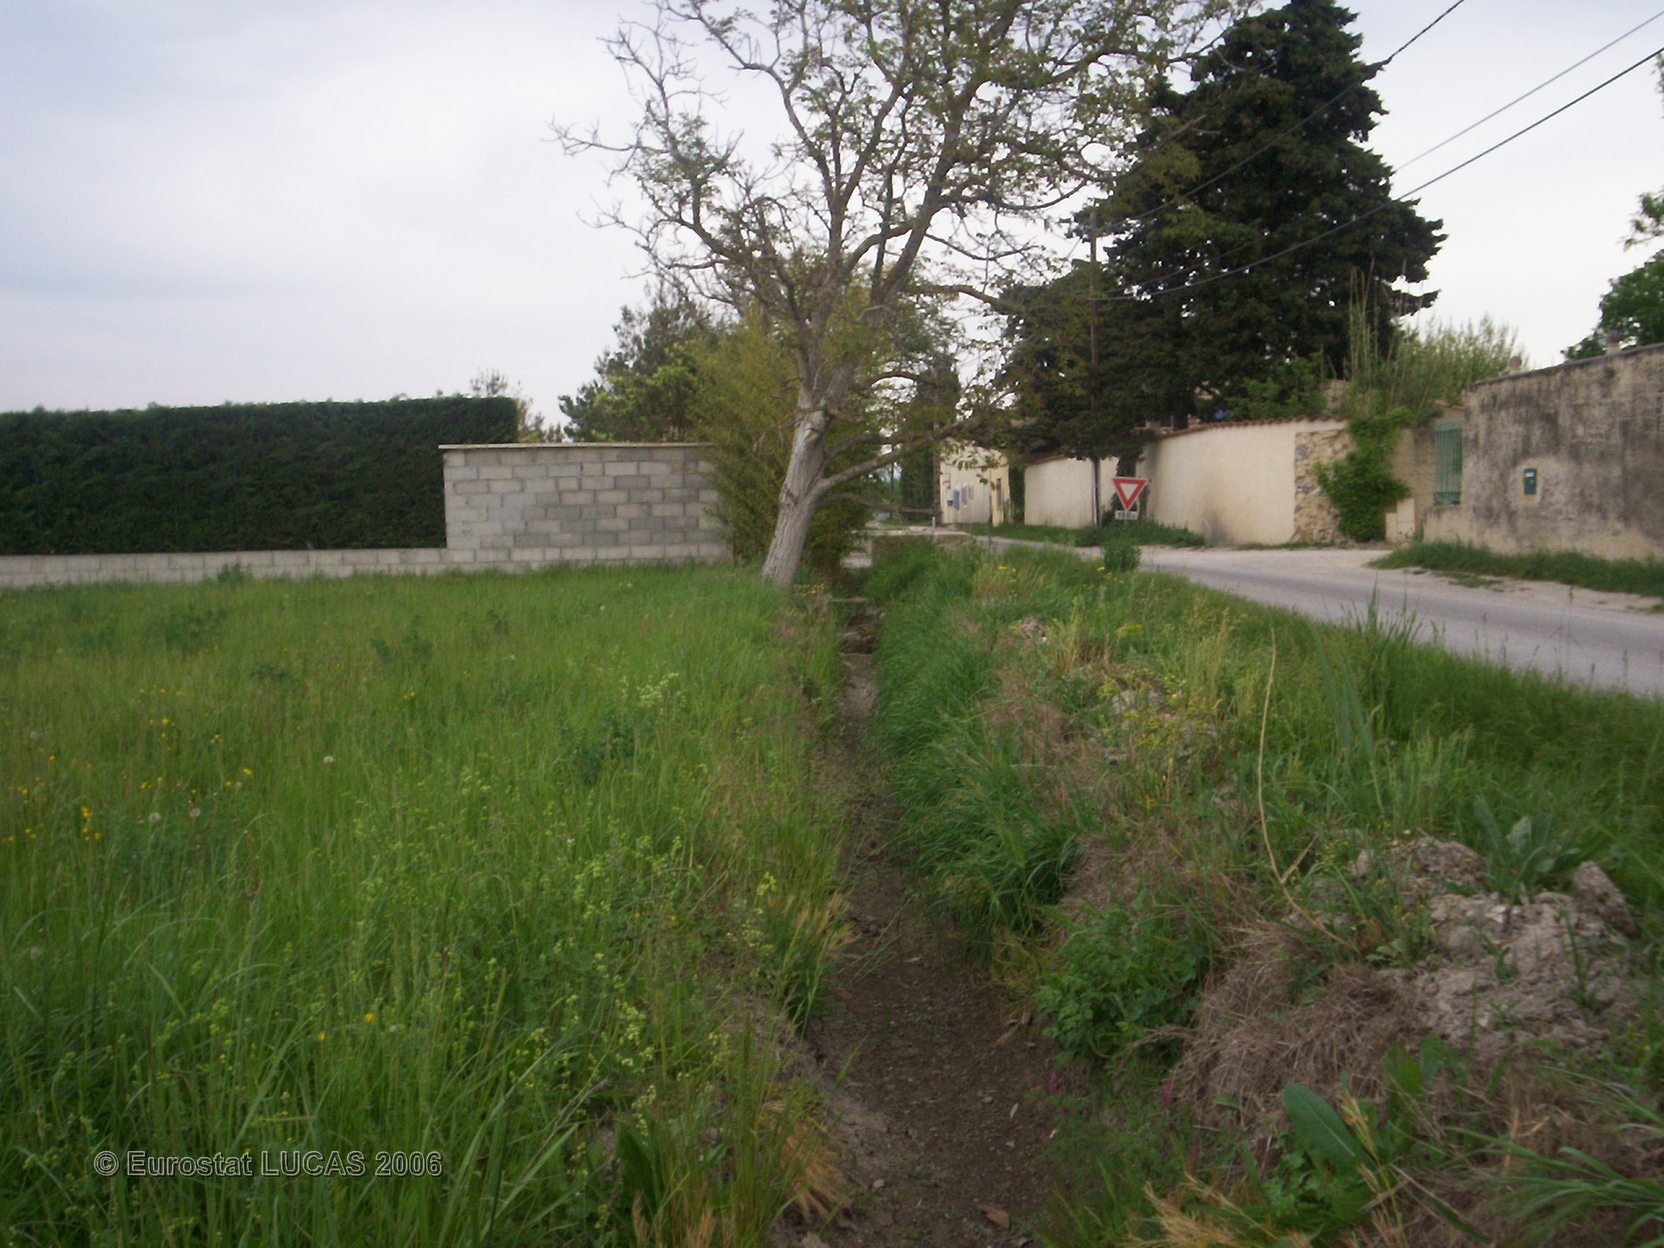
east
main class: Grassland
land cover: Grassland without tree/shrub cover
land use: Agriculture (excluding fallow land and kitchen gardens)
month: April
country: FR
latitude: 44.0483
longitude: 4.9784
